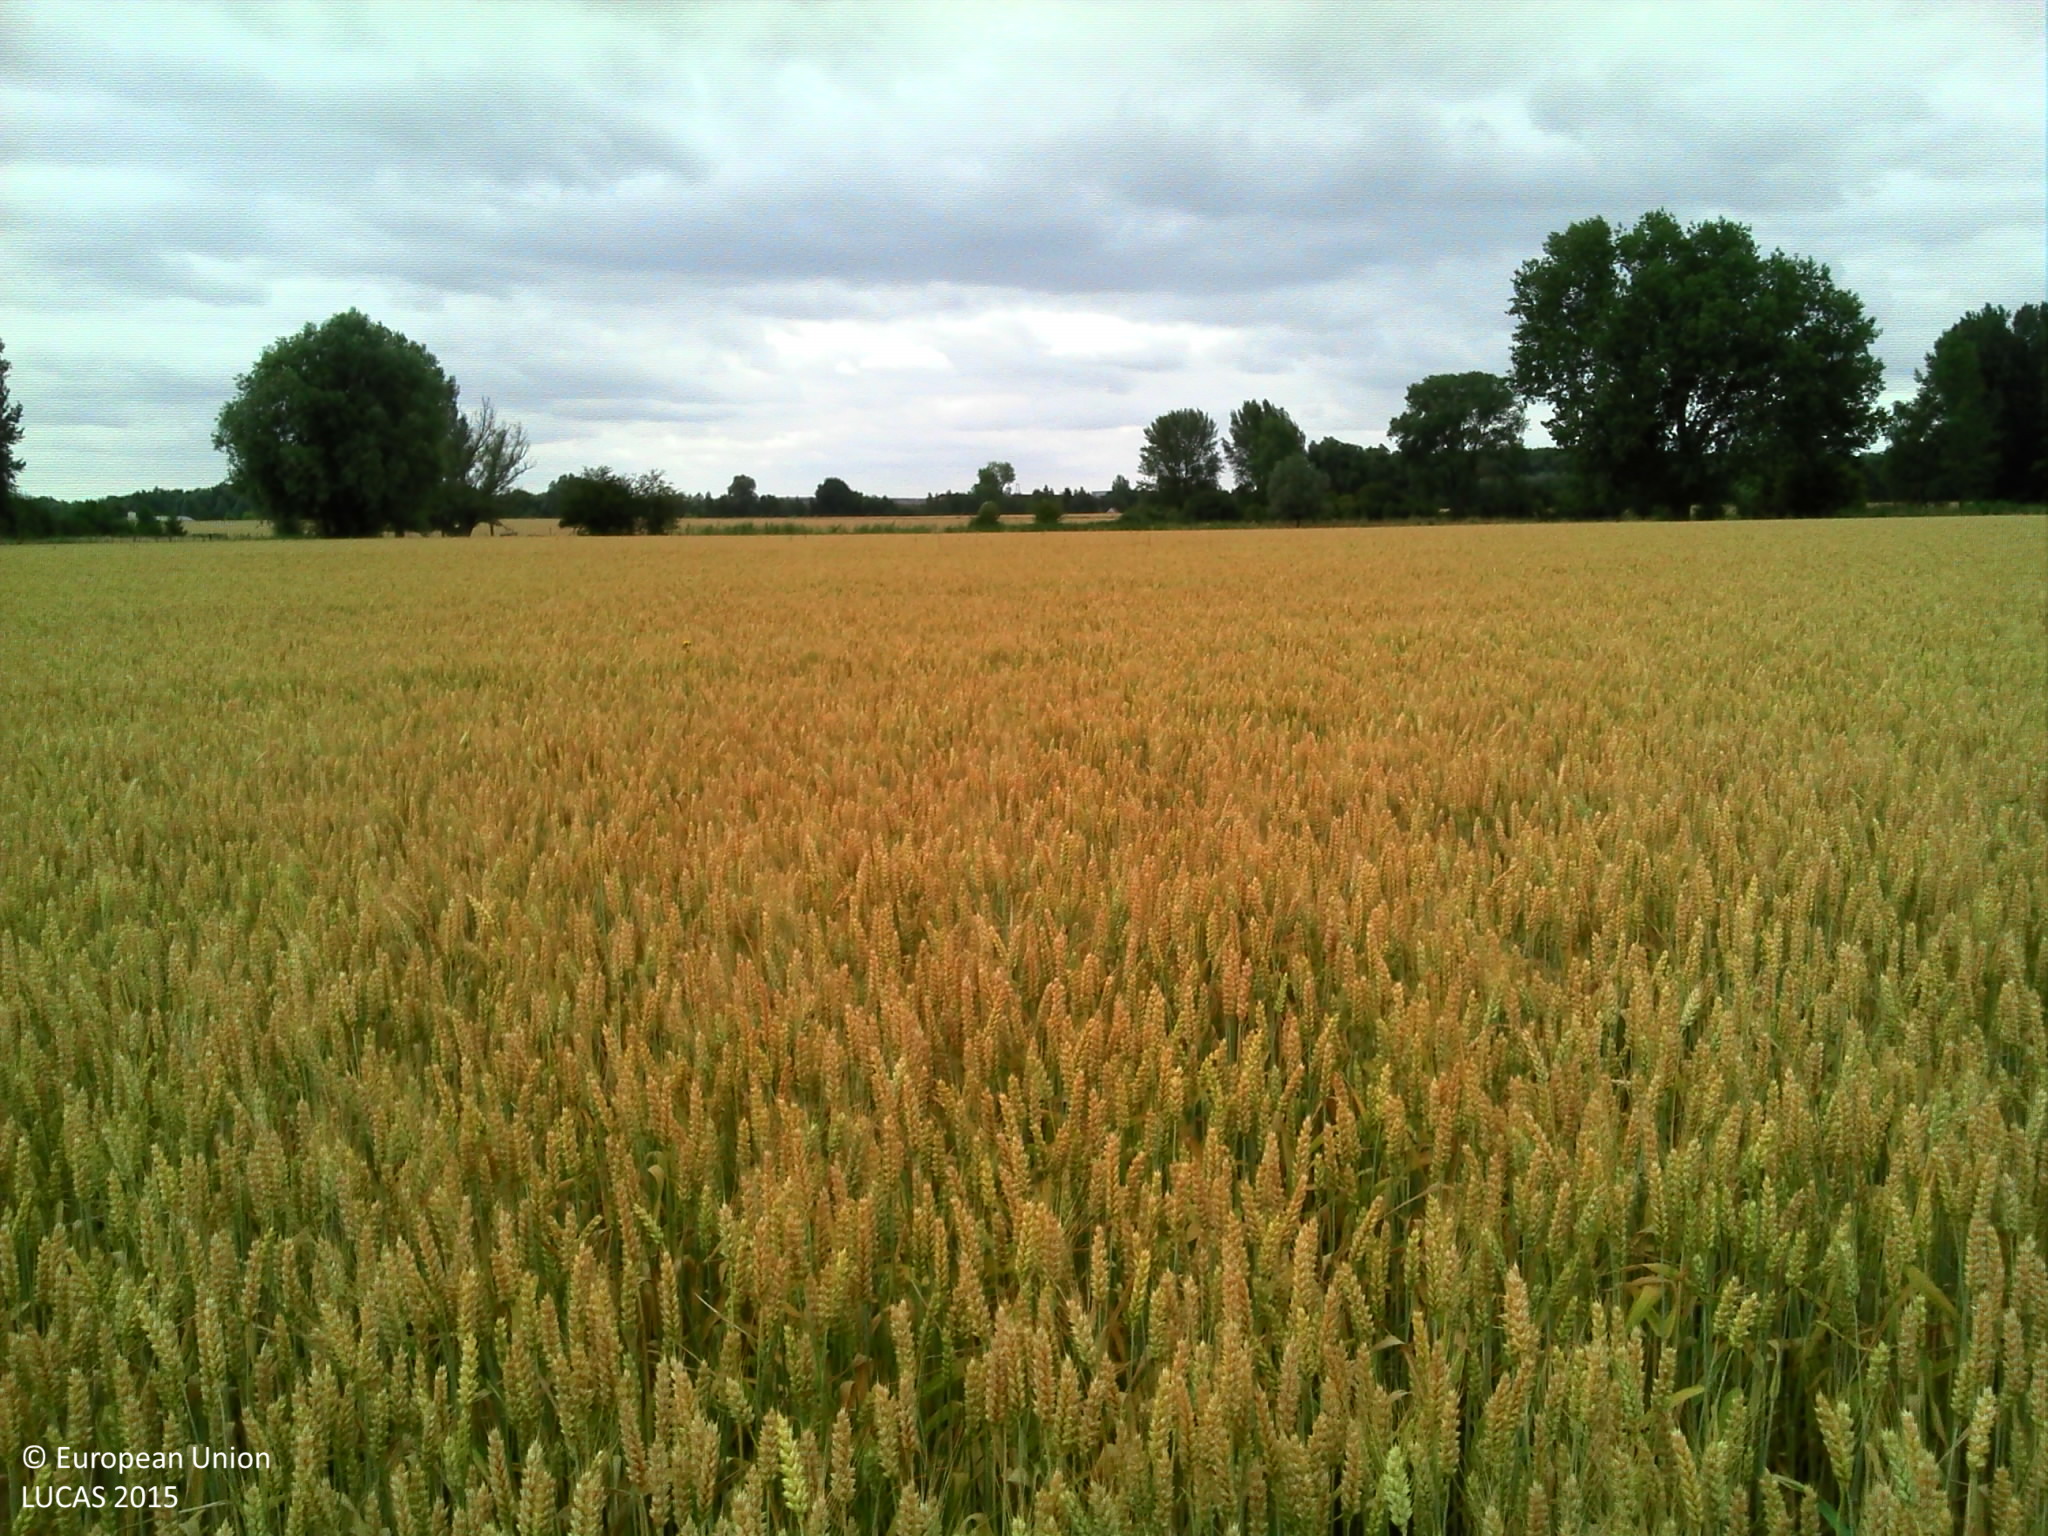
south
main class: Cropland
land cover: Common wheat
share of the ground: > 75 %
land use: Agriculture (excluding fallow land and kitchen gardens)
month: July
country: FR
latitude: 50.4251
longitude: 3.0791
